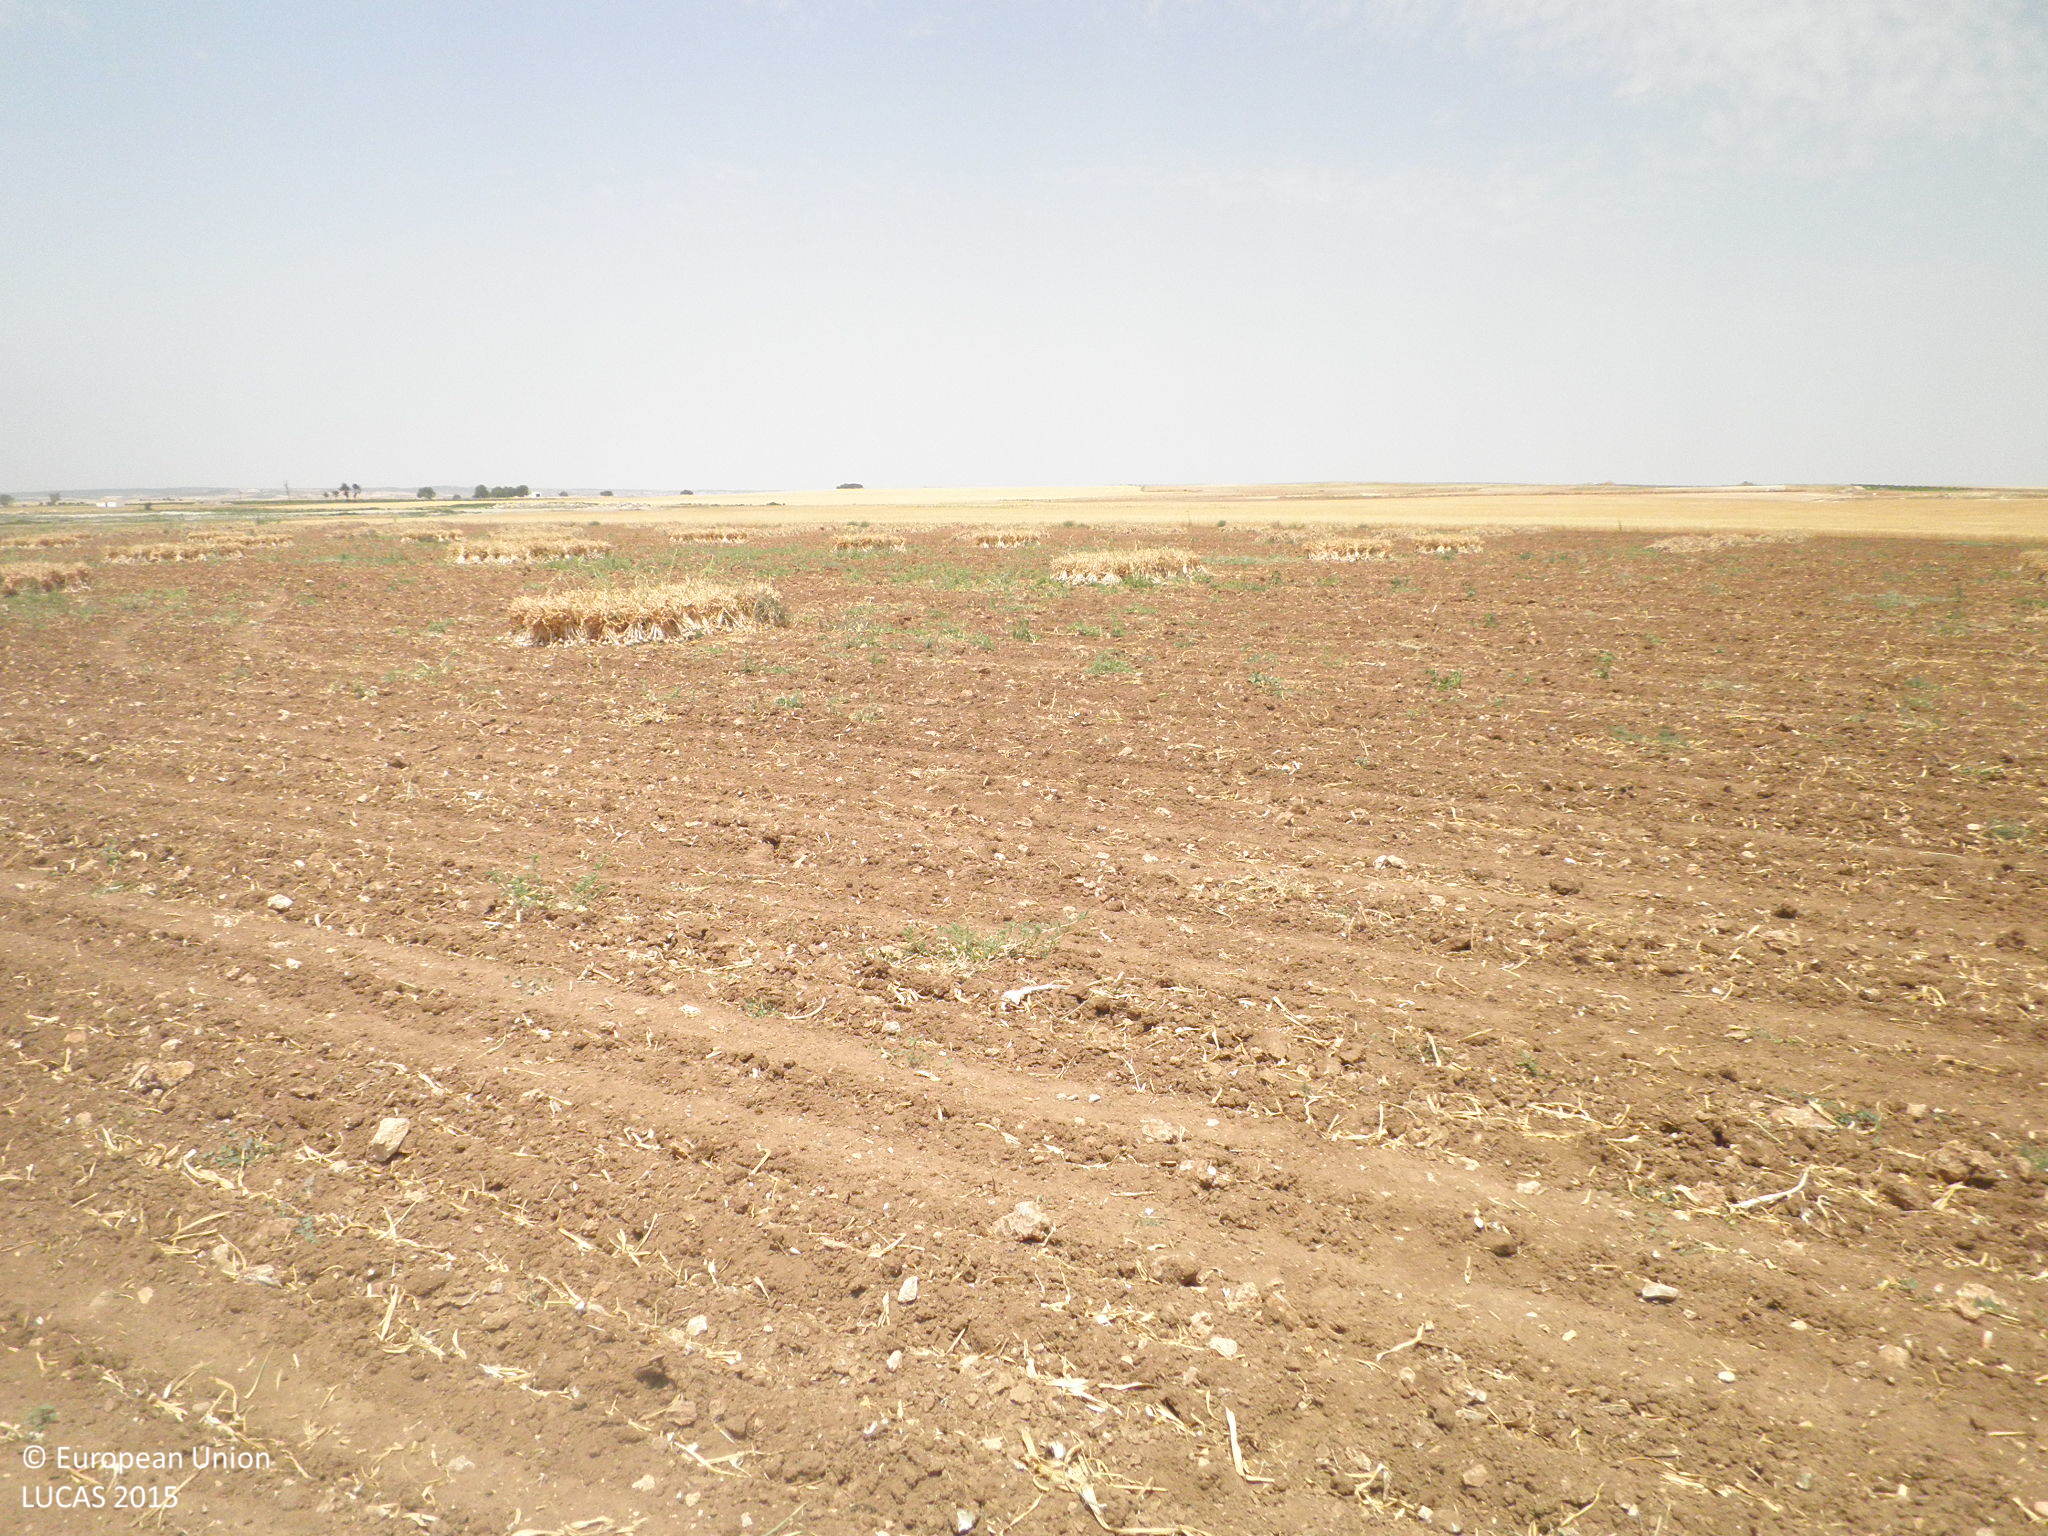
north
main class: Cropland
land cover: Other root crops
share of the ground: < 10 %
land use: Agriculture (excluding fallow land and kitchen gardens)
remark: Harvested field
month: July
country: ES
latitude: 39.5051
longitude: -2.7492
